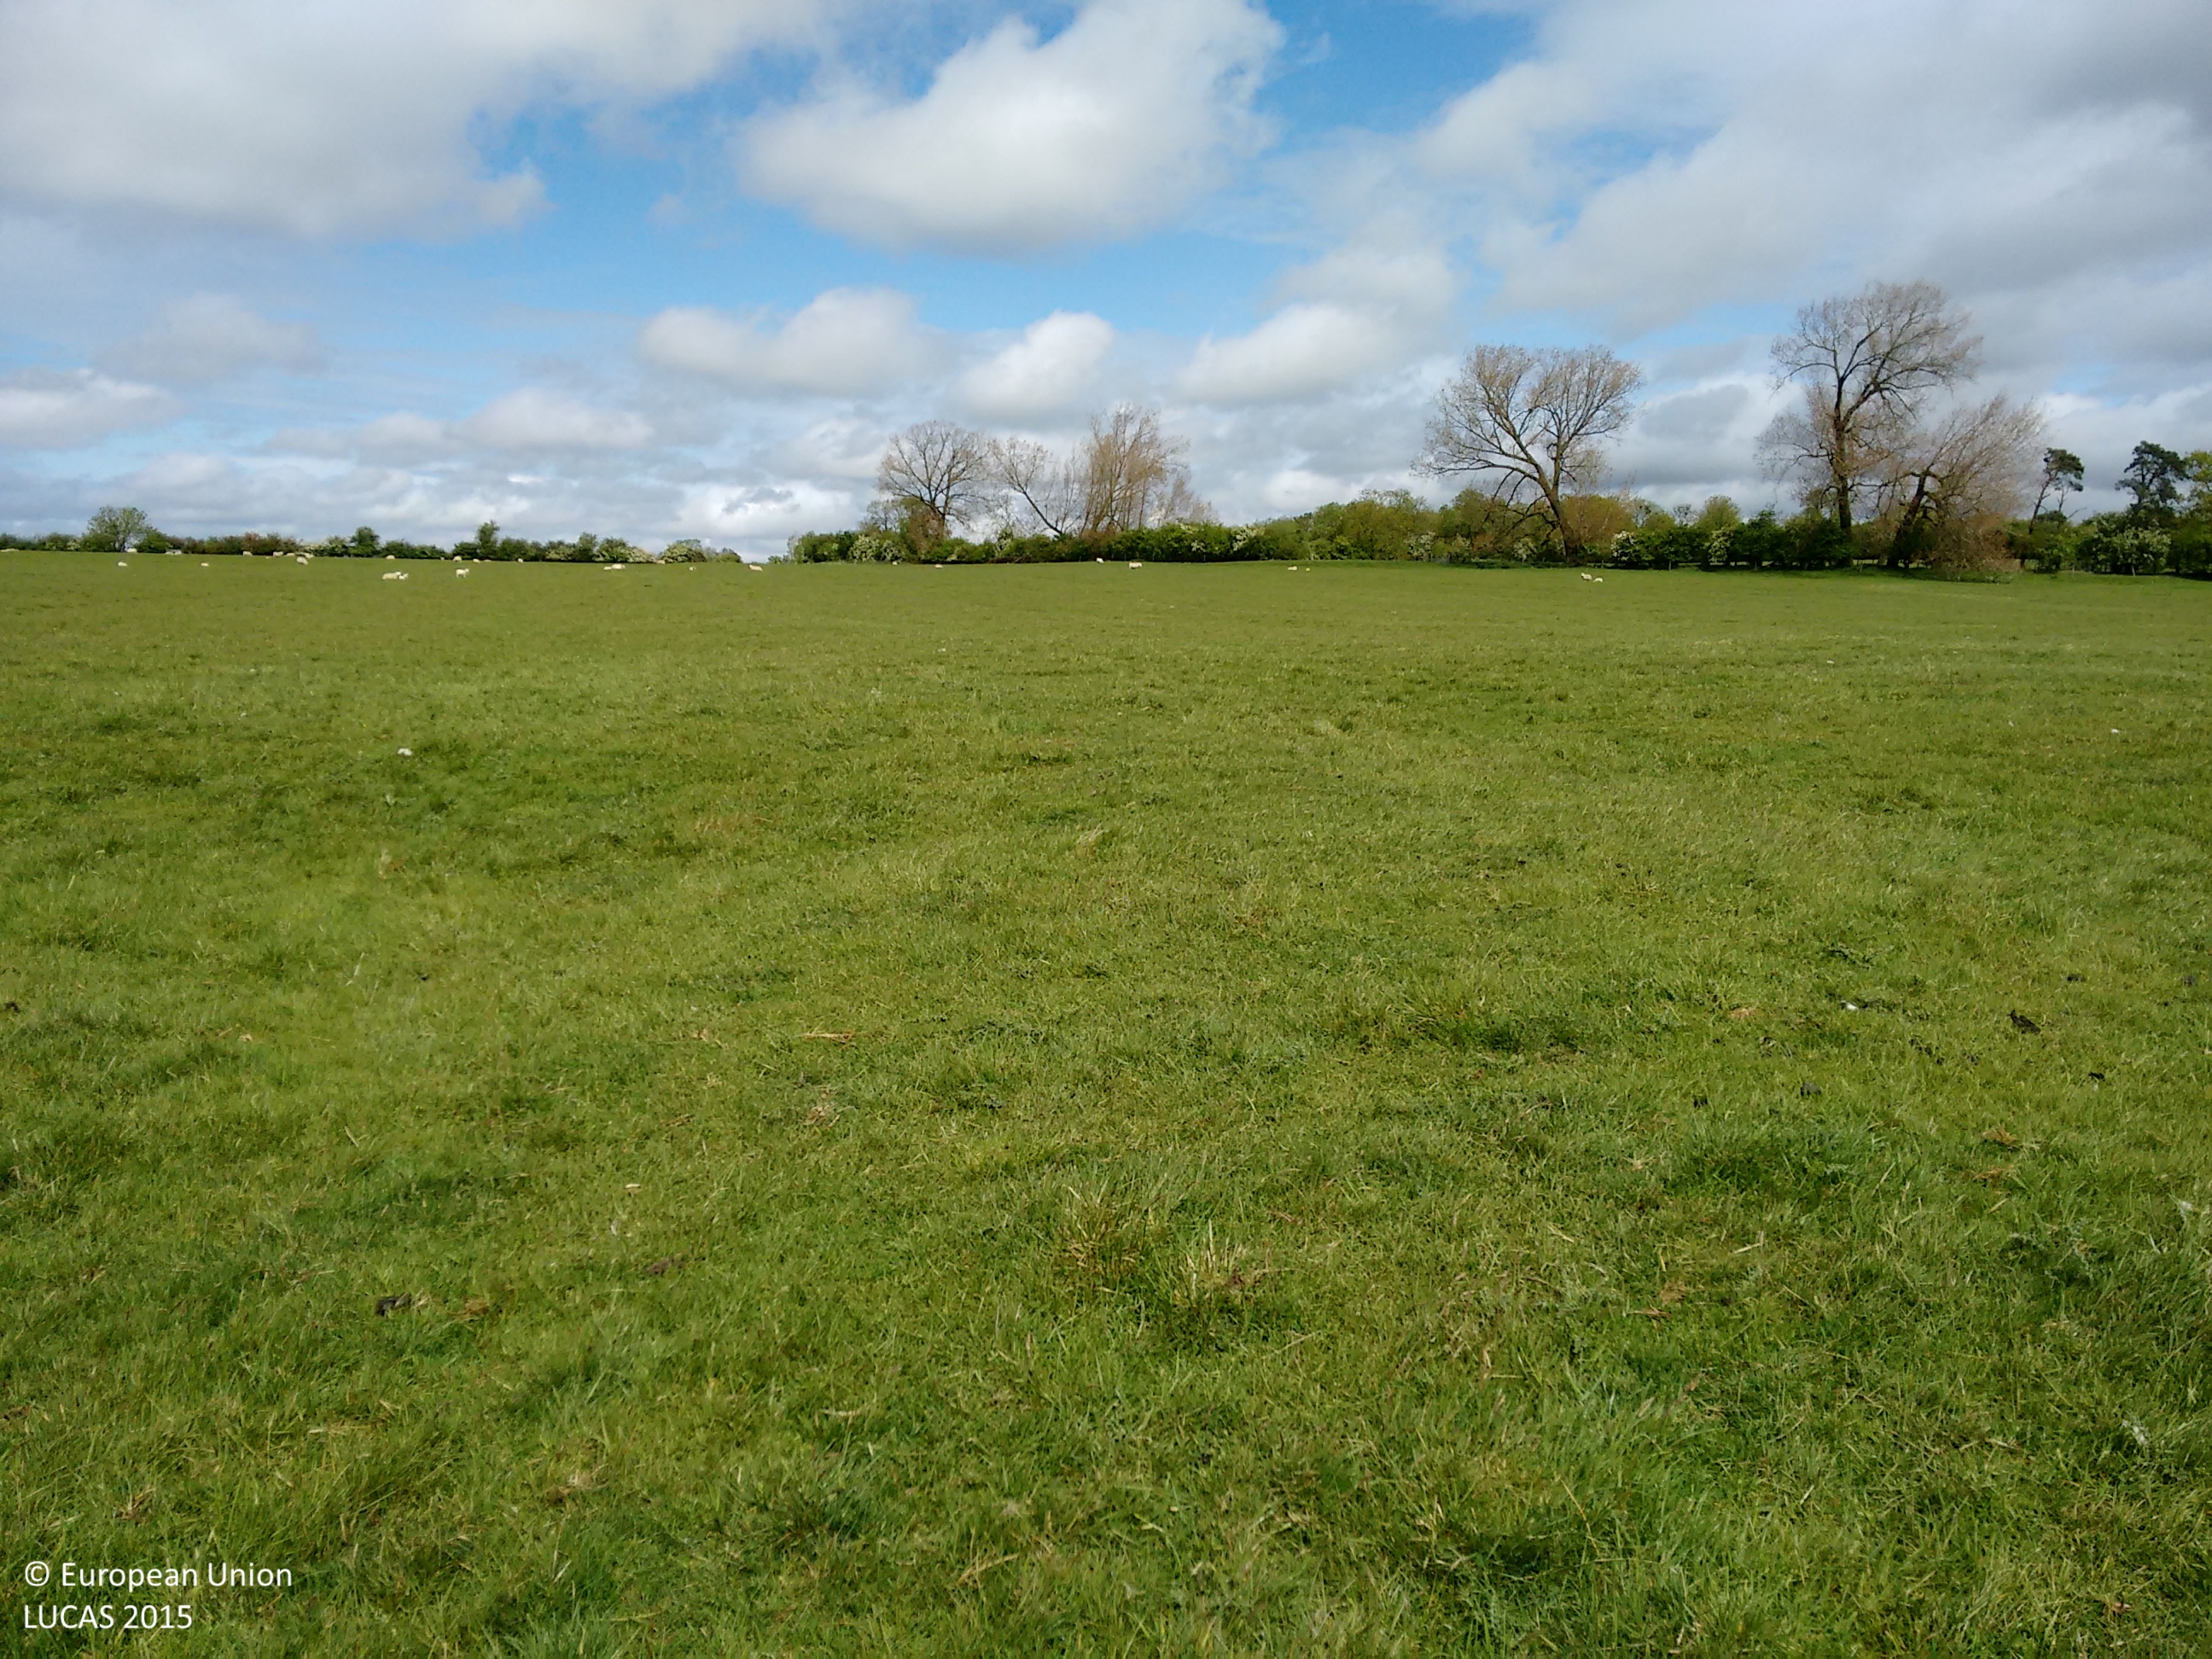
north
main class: Grassland
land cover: Grassland without tree/shrub cover
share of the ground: > 75 %
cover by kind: herbaceous plants 100 %
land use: Agriculture (excluding fallow land and kitchen gardens)
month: May
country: GB
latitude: 52.3139
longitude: -1.2397
